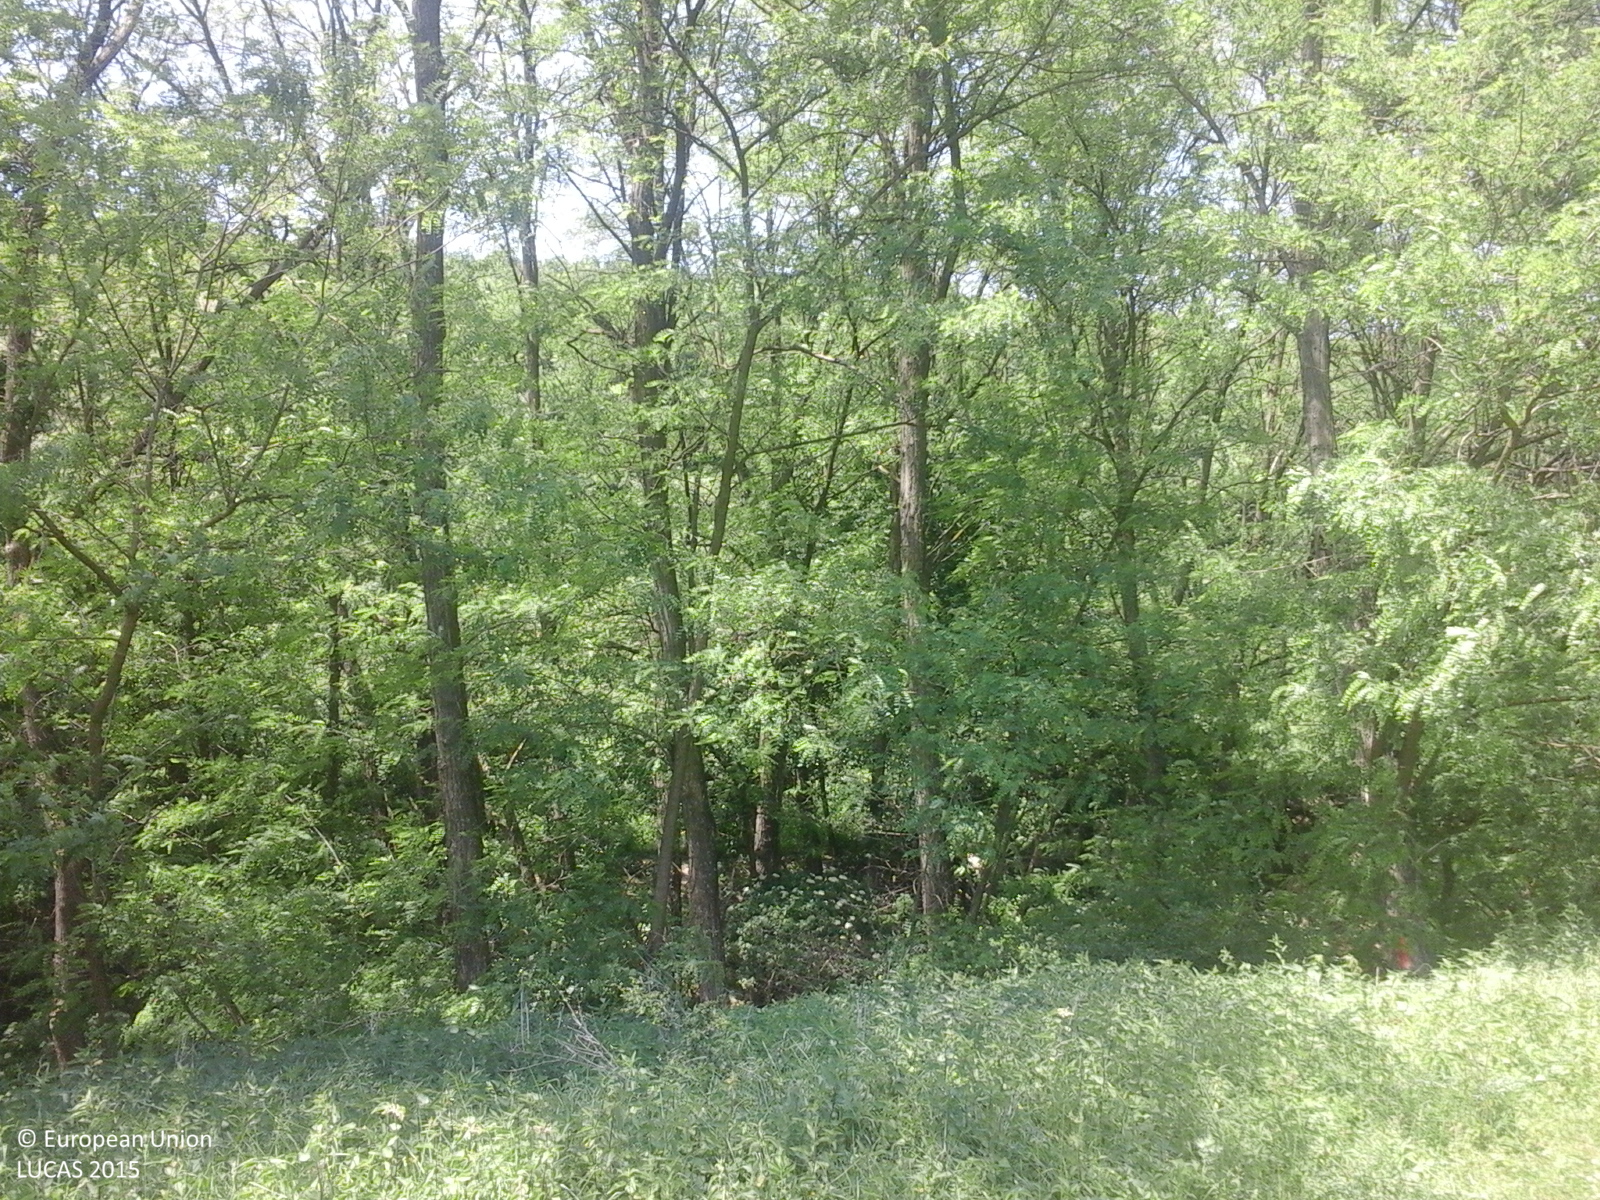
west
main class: Grassland
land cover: Grassland without tree/shrub cover
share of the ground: > 75 %
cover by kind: herbaceous plants 100 %
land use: Agriculture (excluding fallow land and kitchen gardens)
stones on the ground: < 10 %
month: June
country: RO
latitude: 46.4746
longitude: 27.0682
